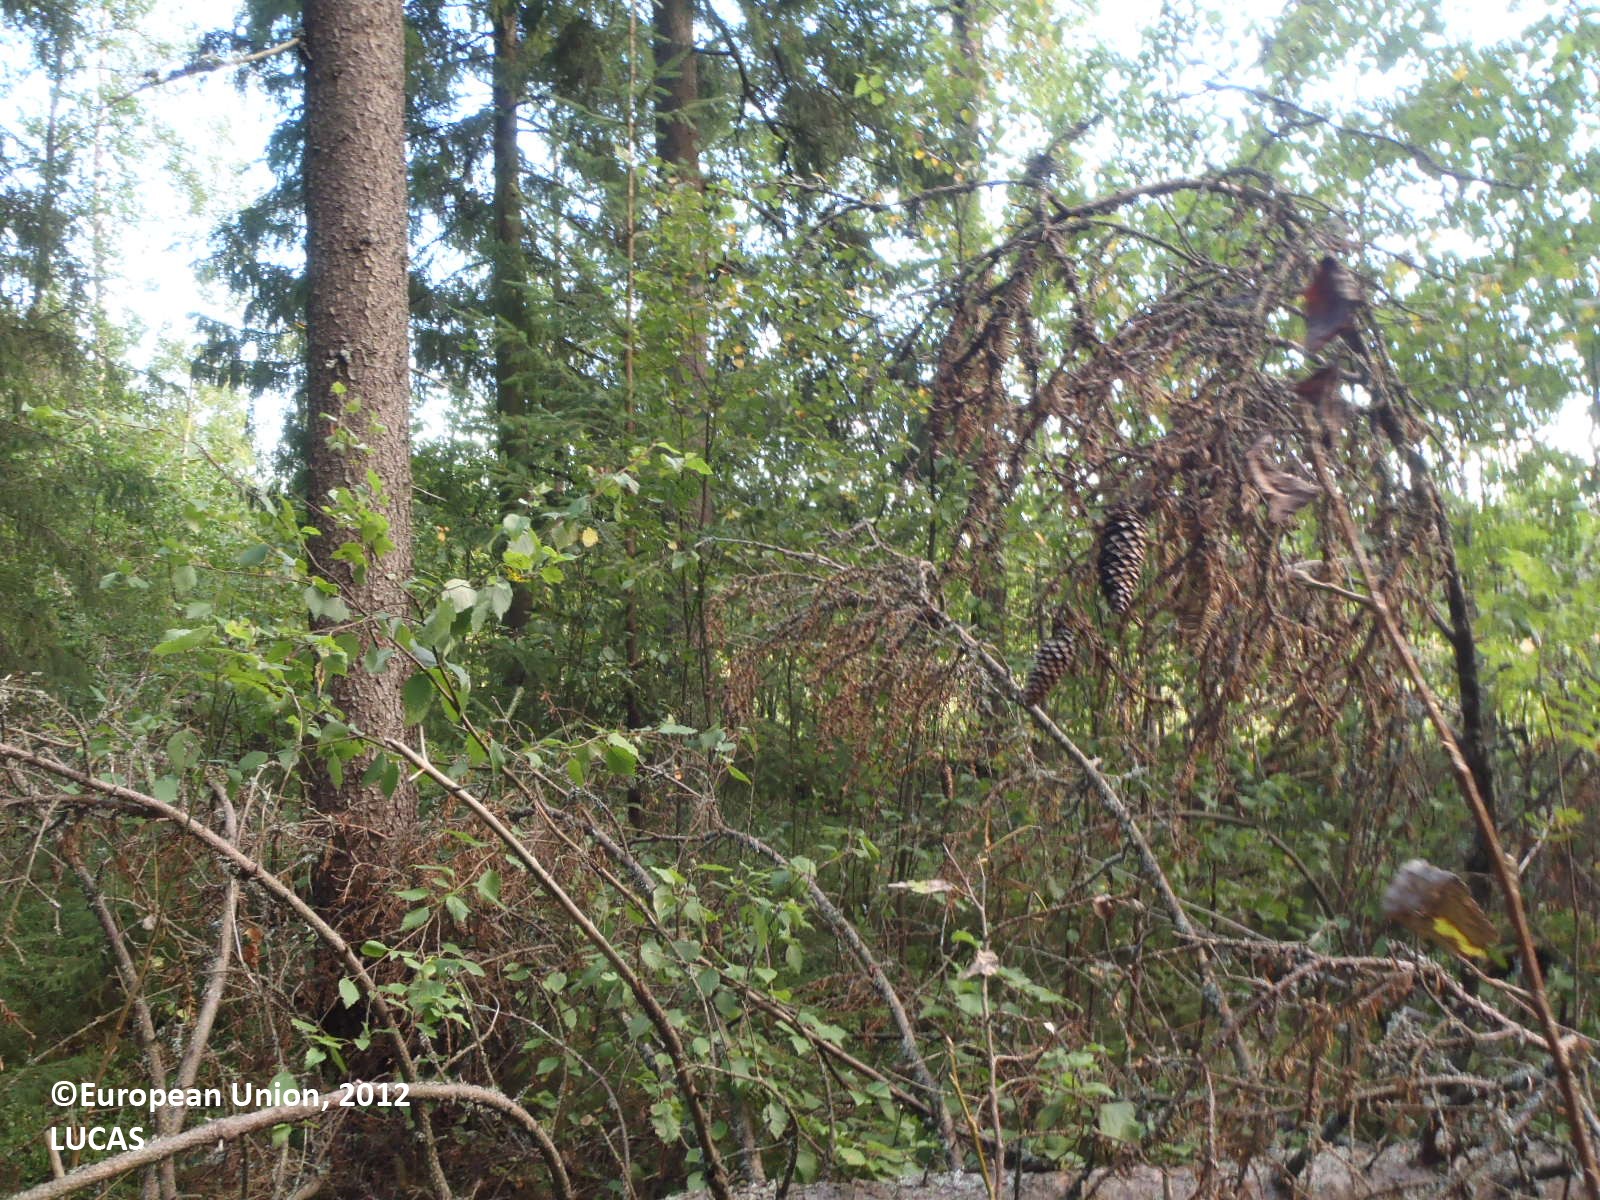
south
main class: Woodland
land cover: Other coniferous woodland
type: boreal forest
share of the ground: > 75 %
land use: Forestry
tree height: > 5 m
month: August
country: FI
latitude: 60.6023
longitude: 22.3585
